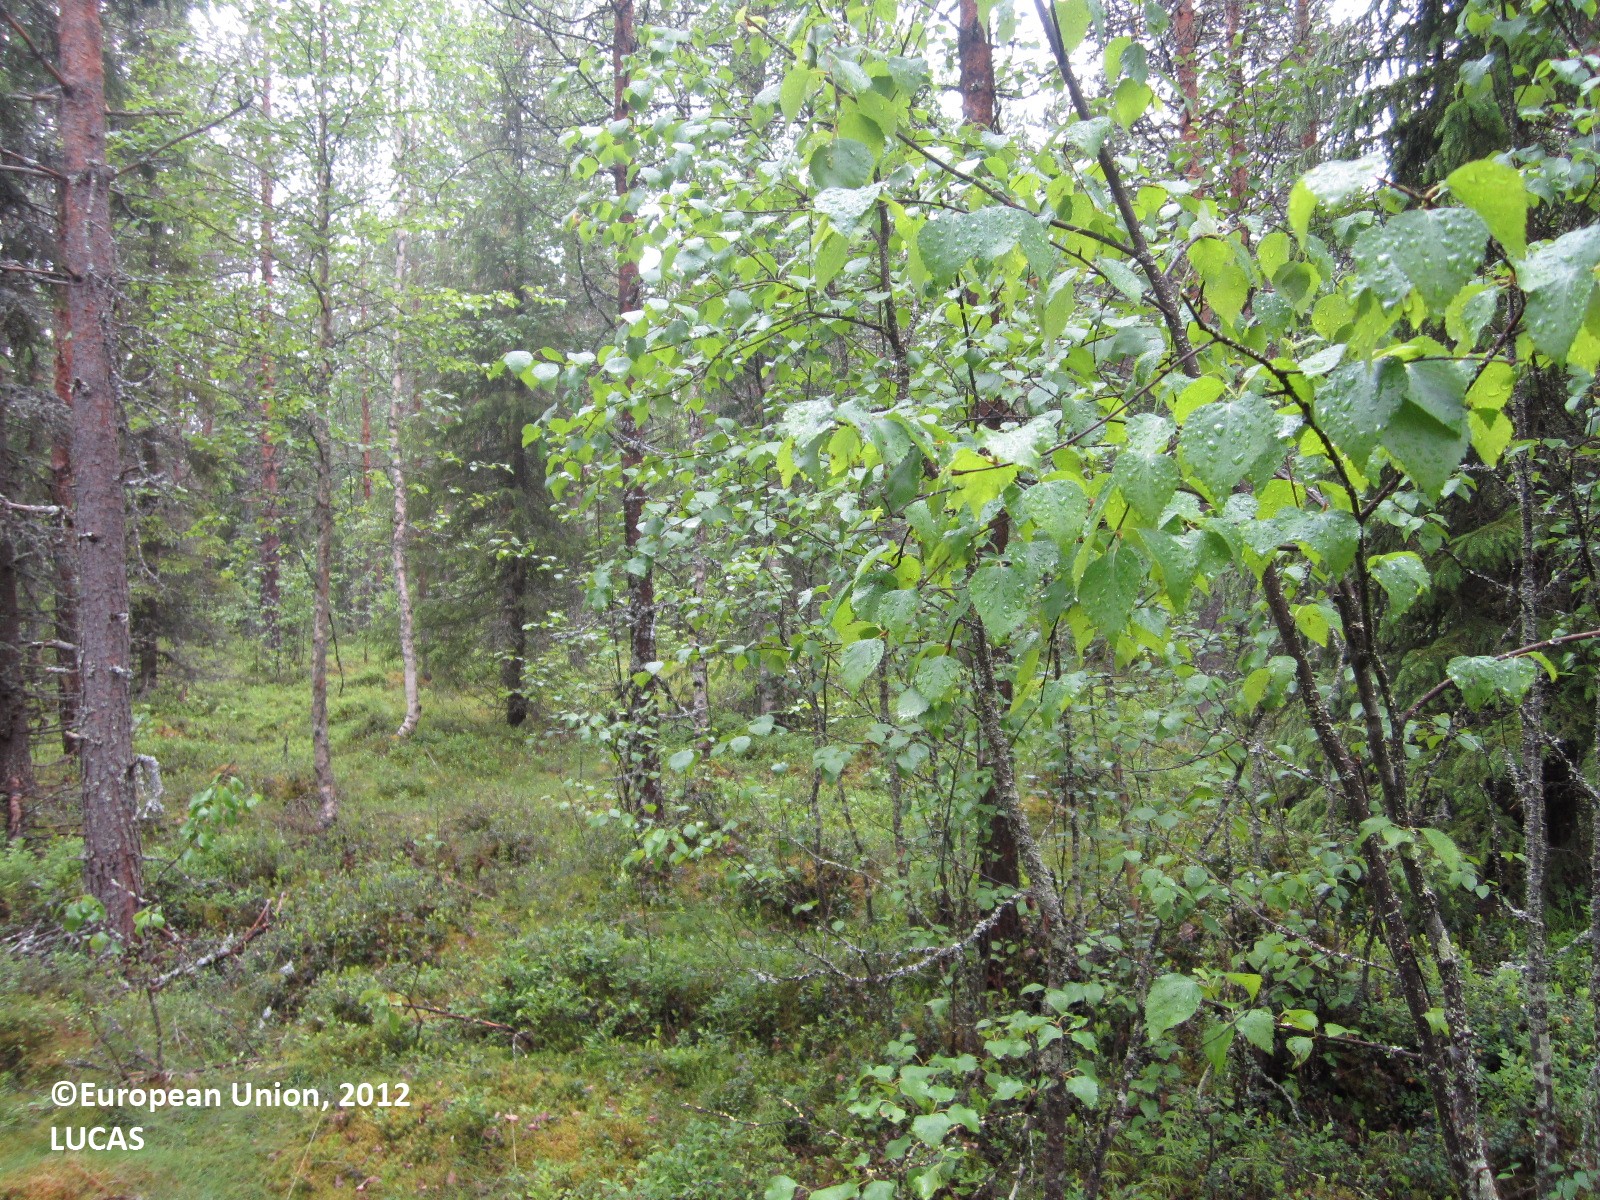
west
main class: Woodland
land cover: Other mixed woodland
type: boreal forest
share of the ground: > 75 %
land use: Forestry
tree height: > 5 m
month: June
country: FI
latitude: 64.5887
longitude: 29.2289
